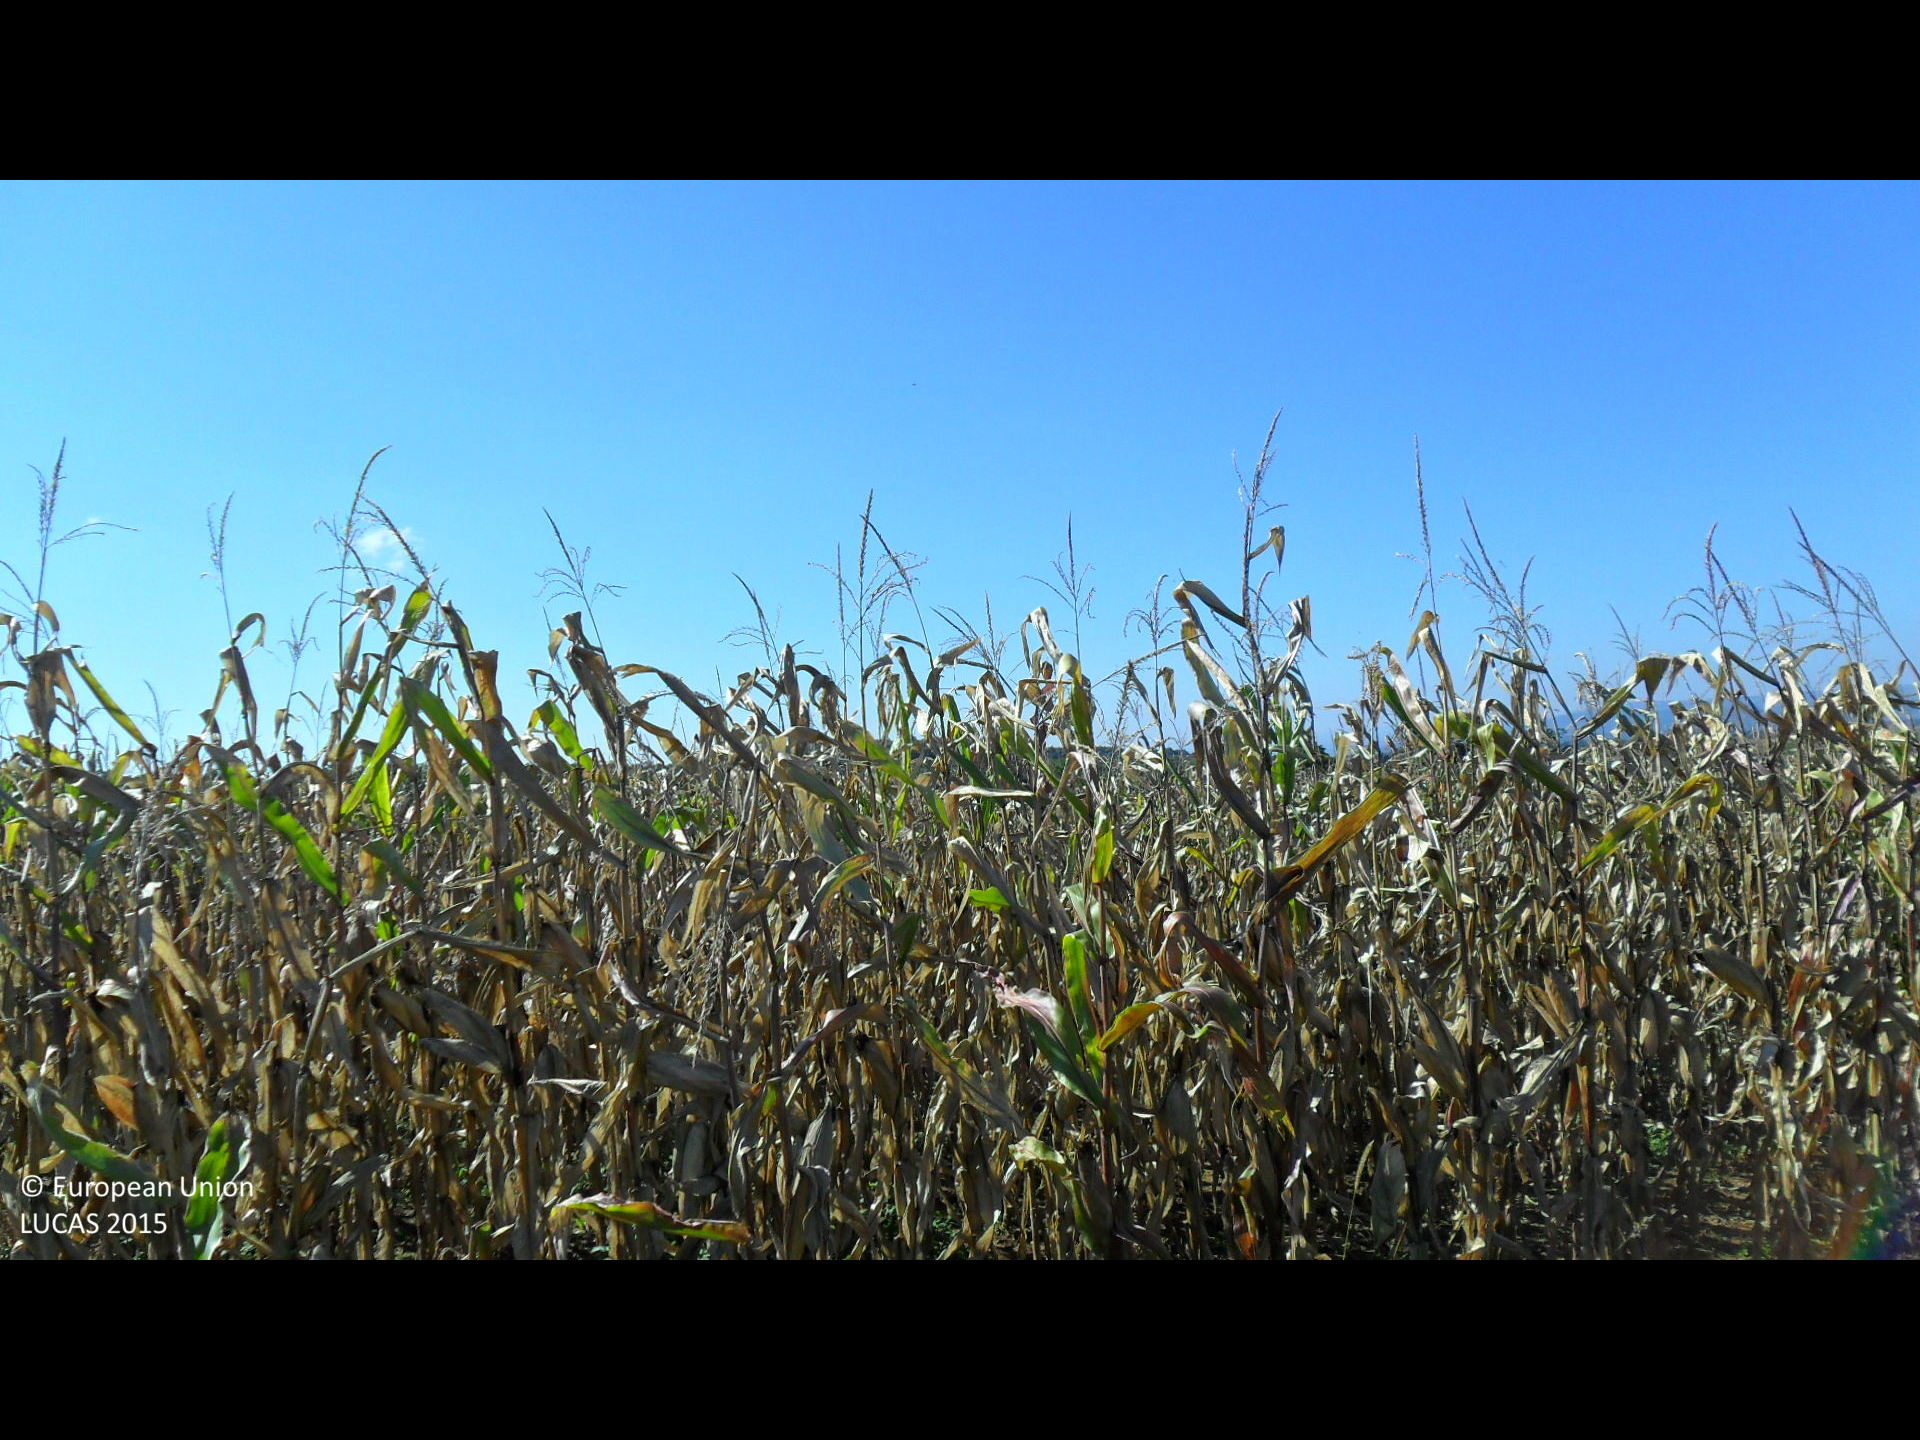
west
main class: Cropland
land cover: Maize
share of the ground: > 75 %
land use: Agriculture (excluding fallow land and kitchen gardens)
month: October
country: BG
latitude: 43.1407
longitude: 26.0861
